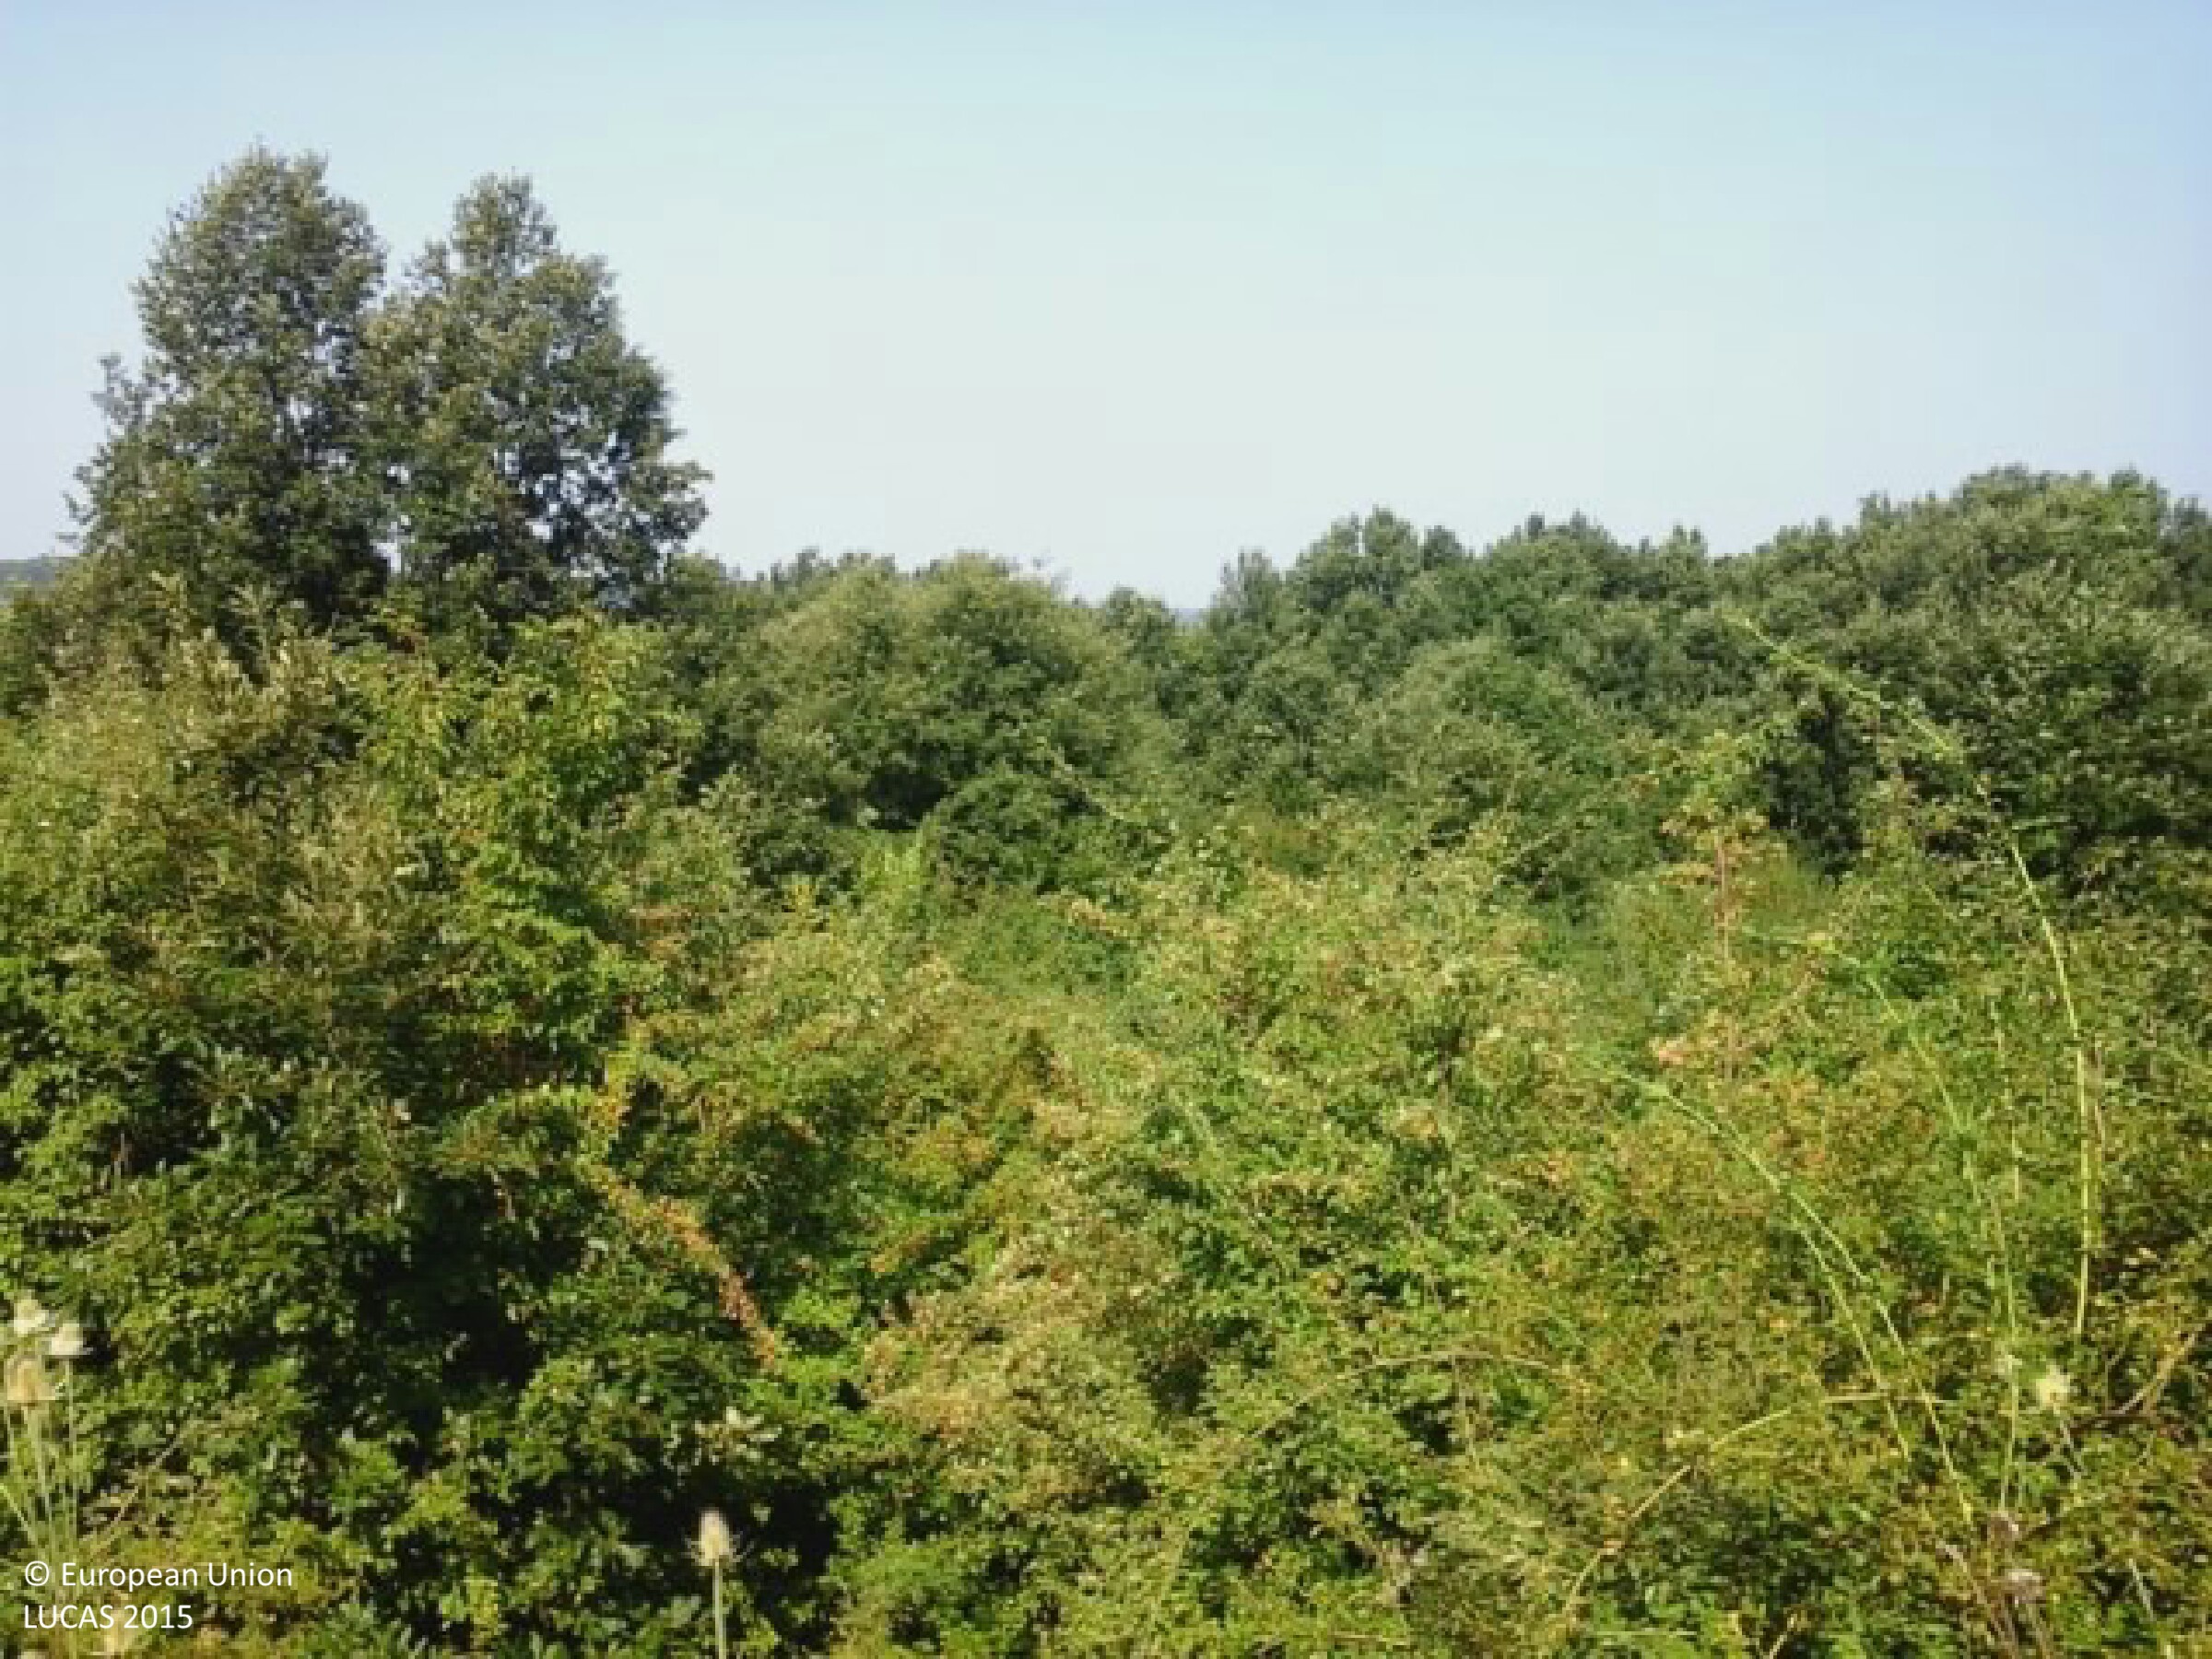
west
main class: Woodland
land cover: Broadleaved woodland
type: mesophytic deciduous forest
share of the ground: > 75 %
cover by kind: broadleaved forest trees 90 %, shrubs 5 %, herbaceous plants 5 %
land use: Forestry
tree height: > 5 m
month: August
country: HU
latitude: 46.2375
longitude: 17.9296
